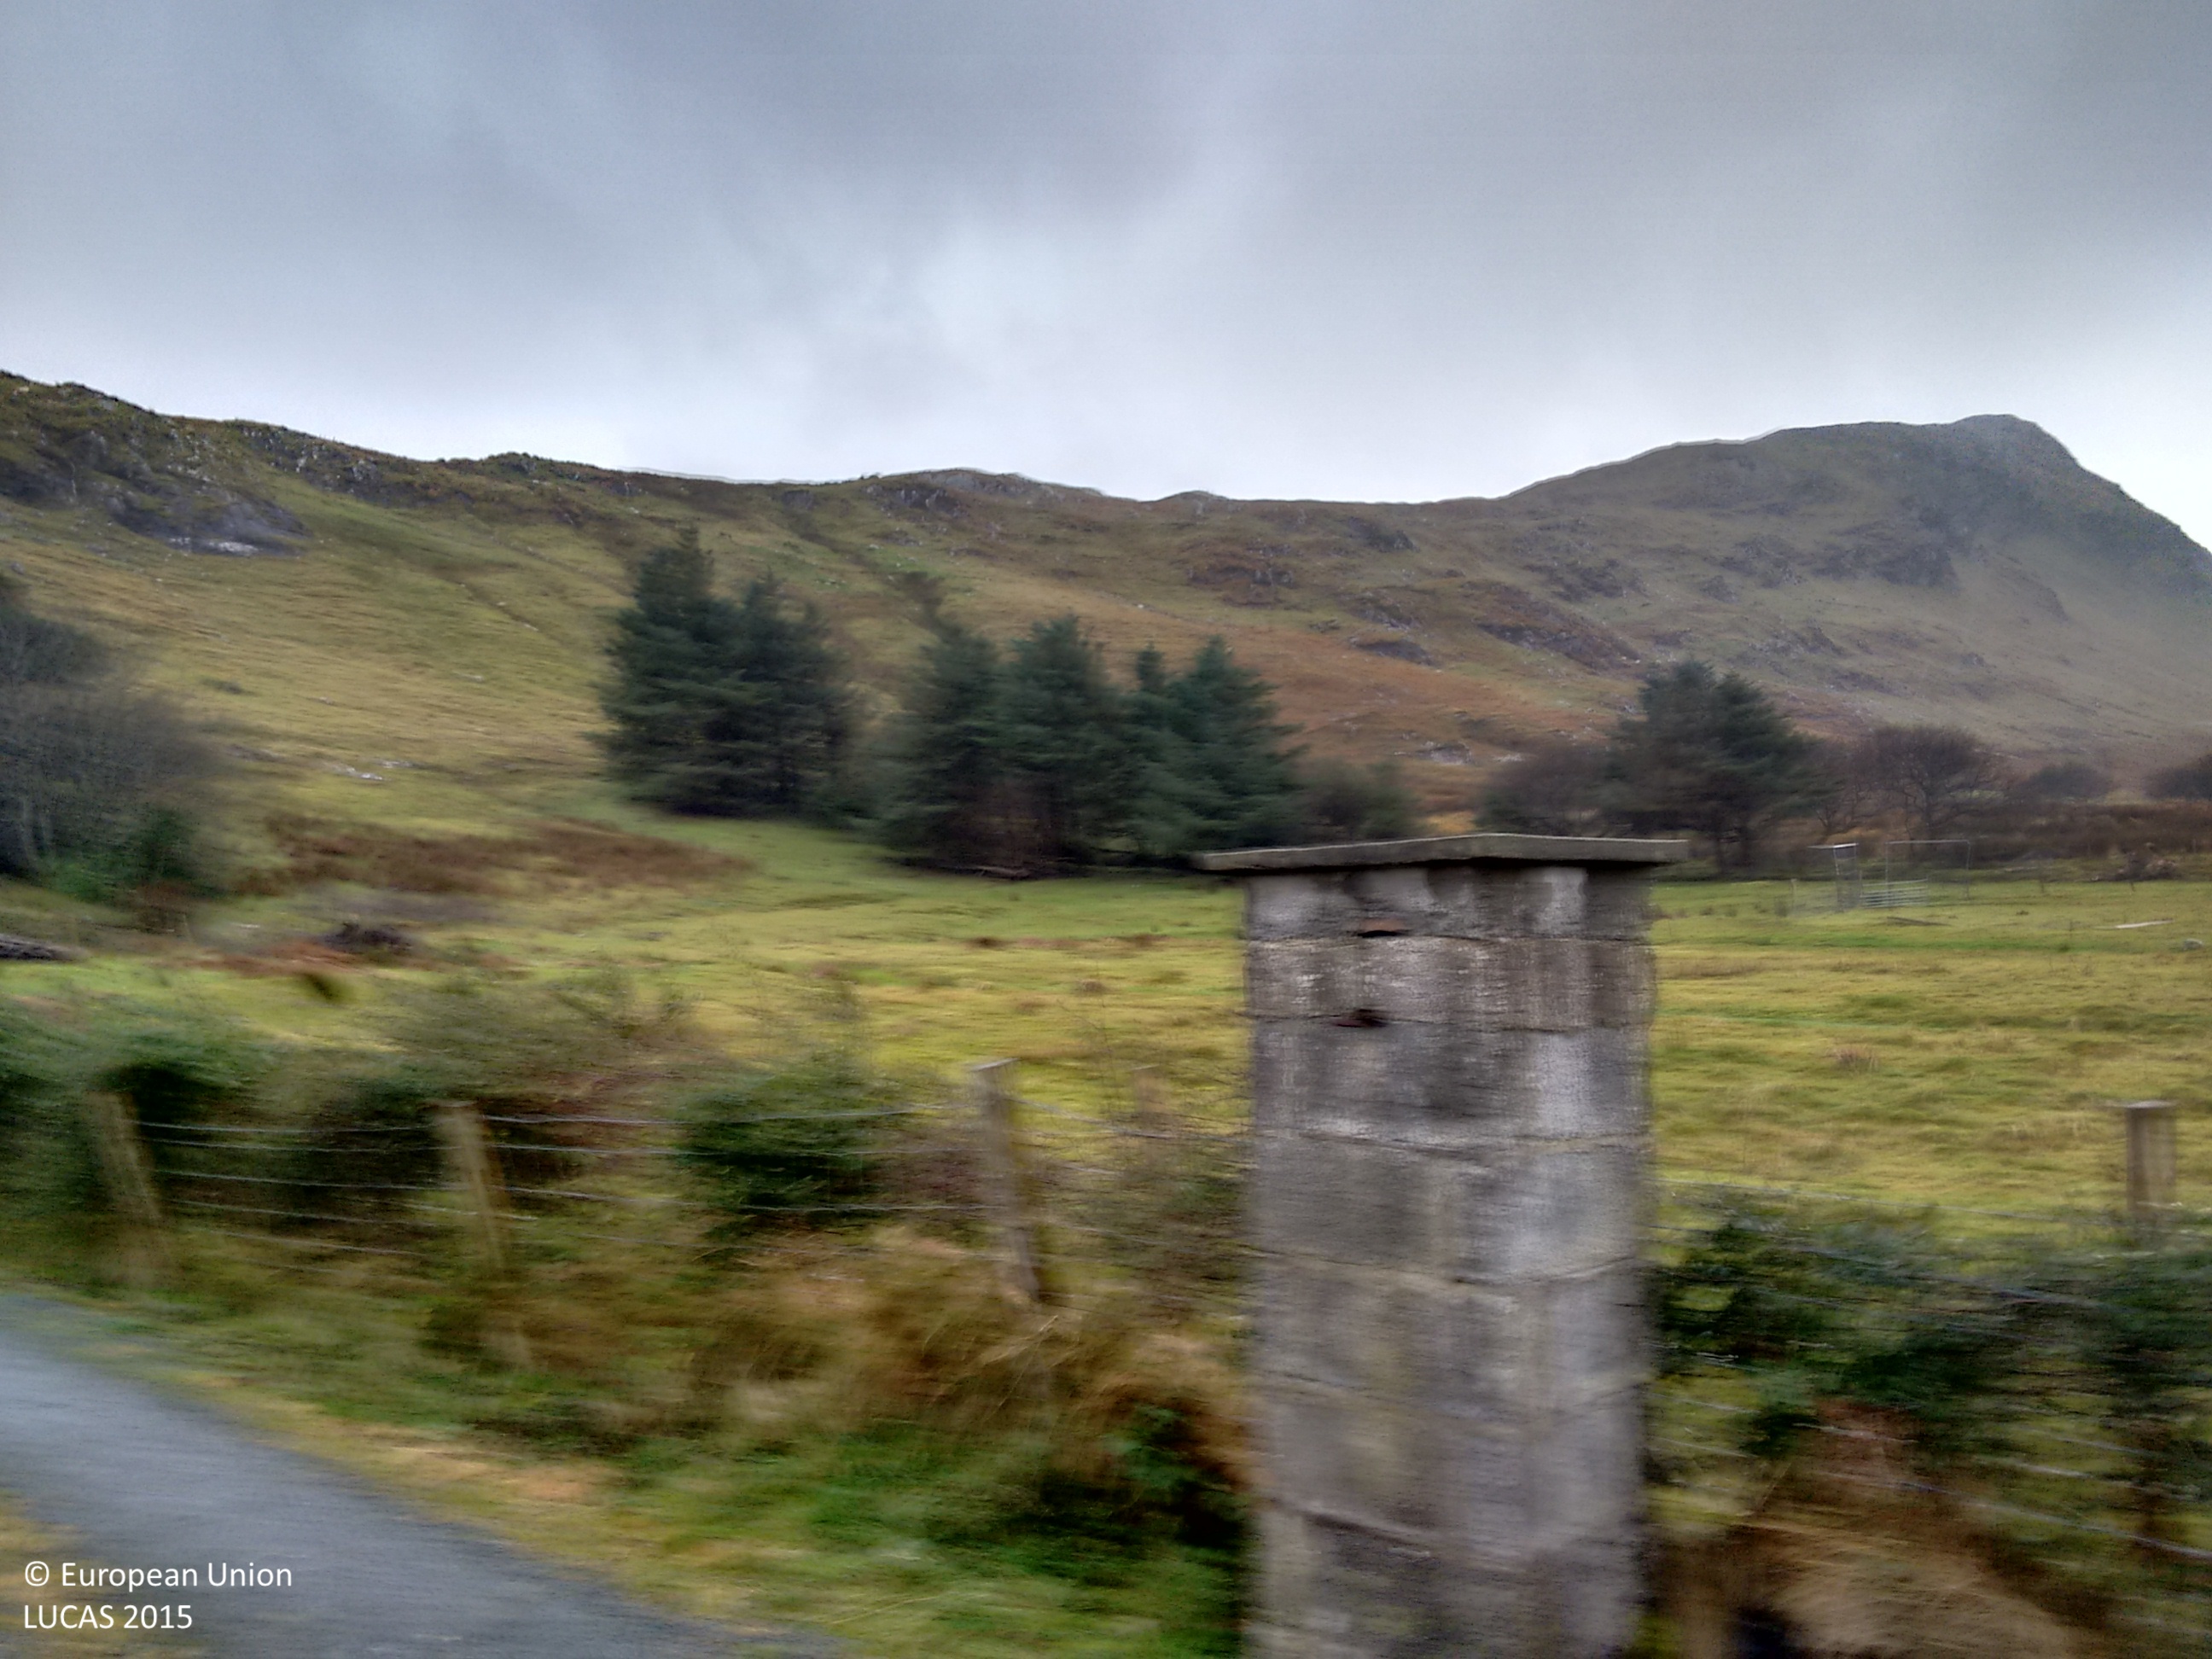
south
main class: Grassland
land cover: Grassland without tree/shrub cover
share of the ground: > 75 %
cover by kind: herbaceous plants 80 %, lichens and mosses 20 %
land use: Agriculture (excluding fallow land and kitchen gardens)
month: November
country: IE
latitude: 54.7403
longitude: -8.4391
